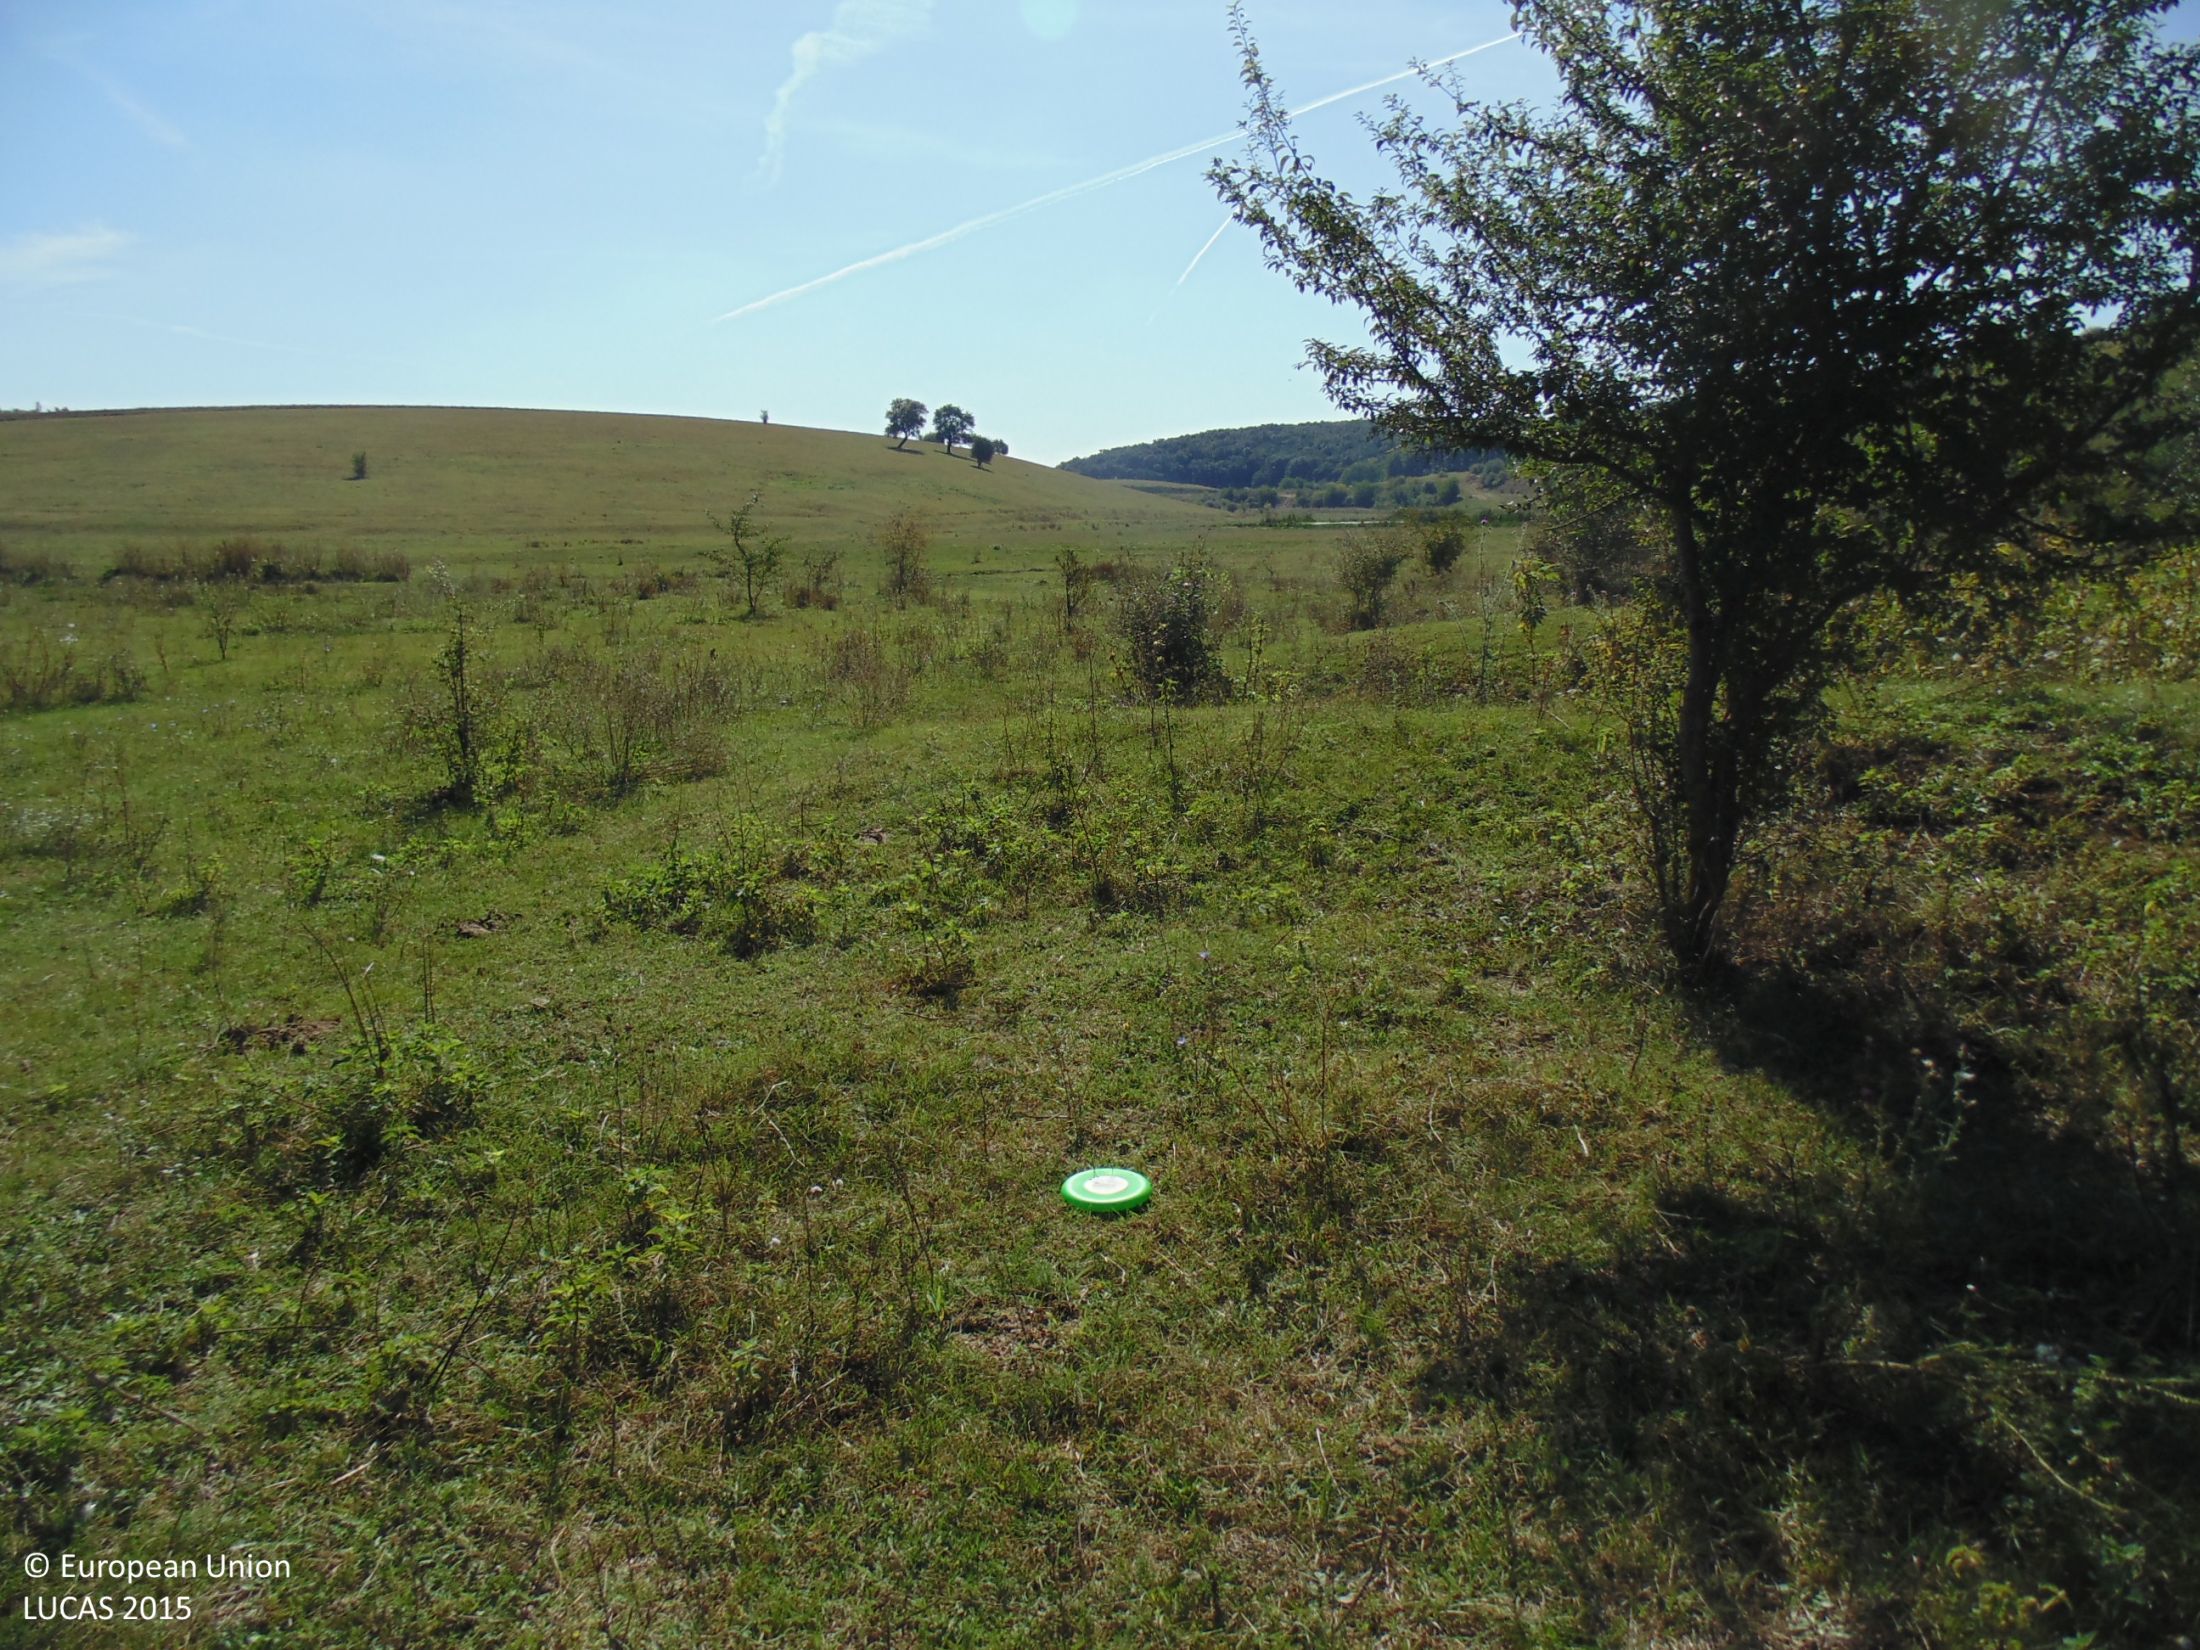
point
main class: Grassland
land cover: Grassland with sparse tree/shrub cover
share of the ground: > 75 %
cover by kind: herbaceous plants 90 %, broadleaved forest trees 5 %, shrubs 5 %
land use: Agriculture (excluding fallow land and kitchen gardens)
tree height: < 5 m
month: September
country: BG
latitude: 44.0514
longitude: 27.0375
